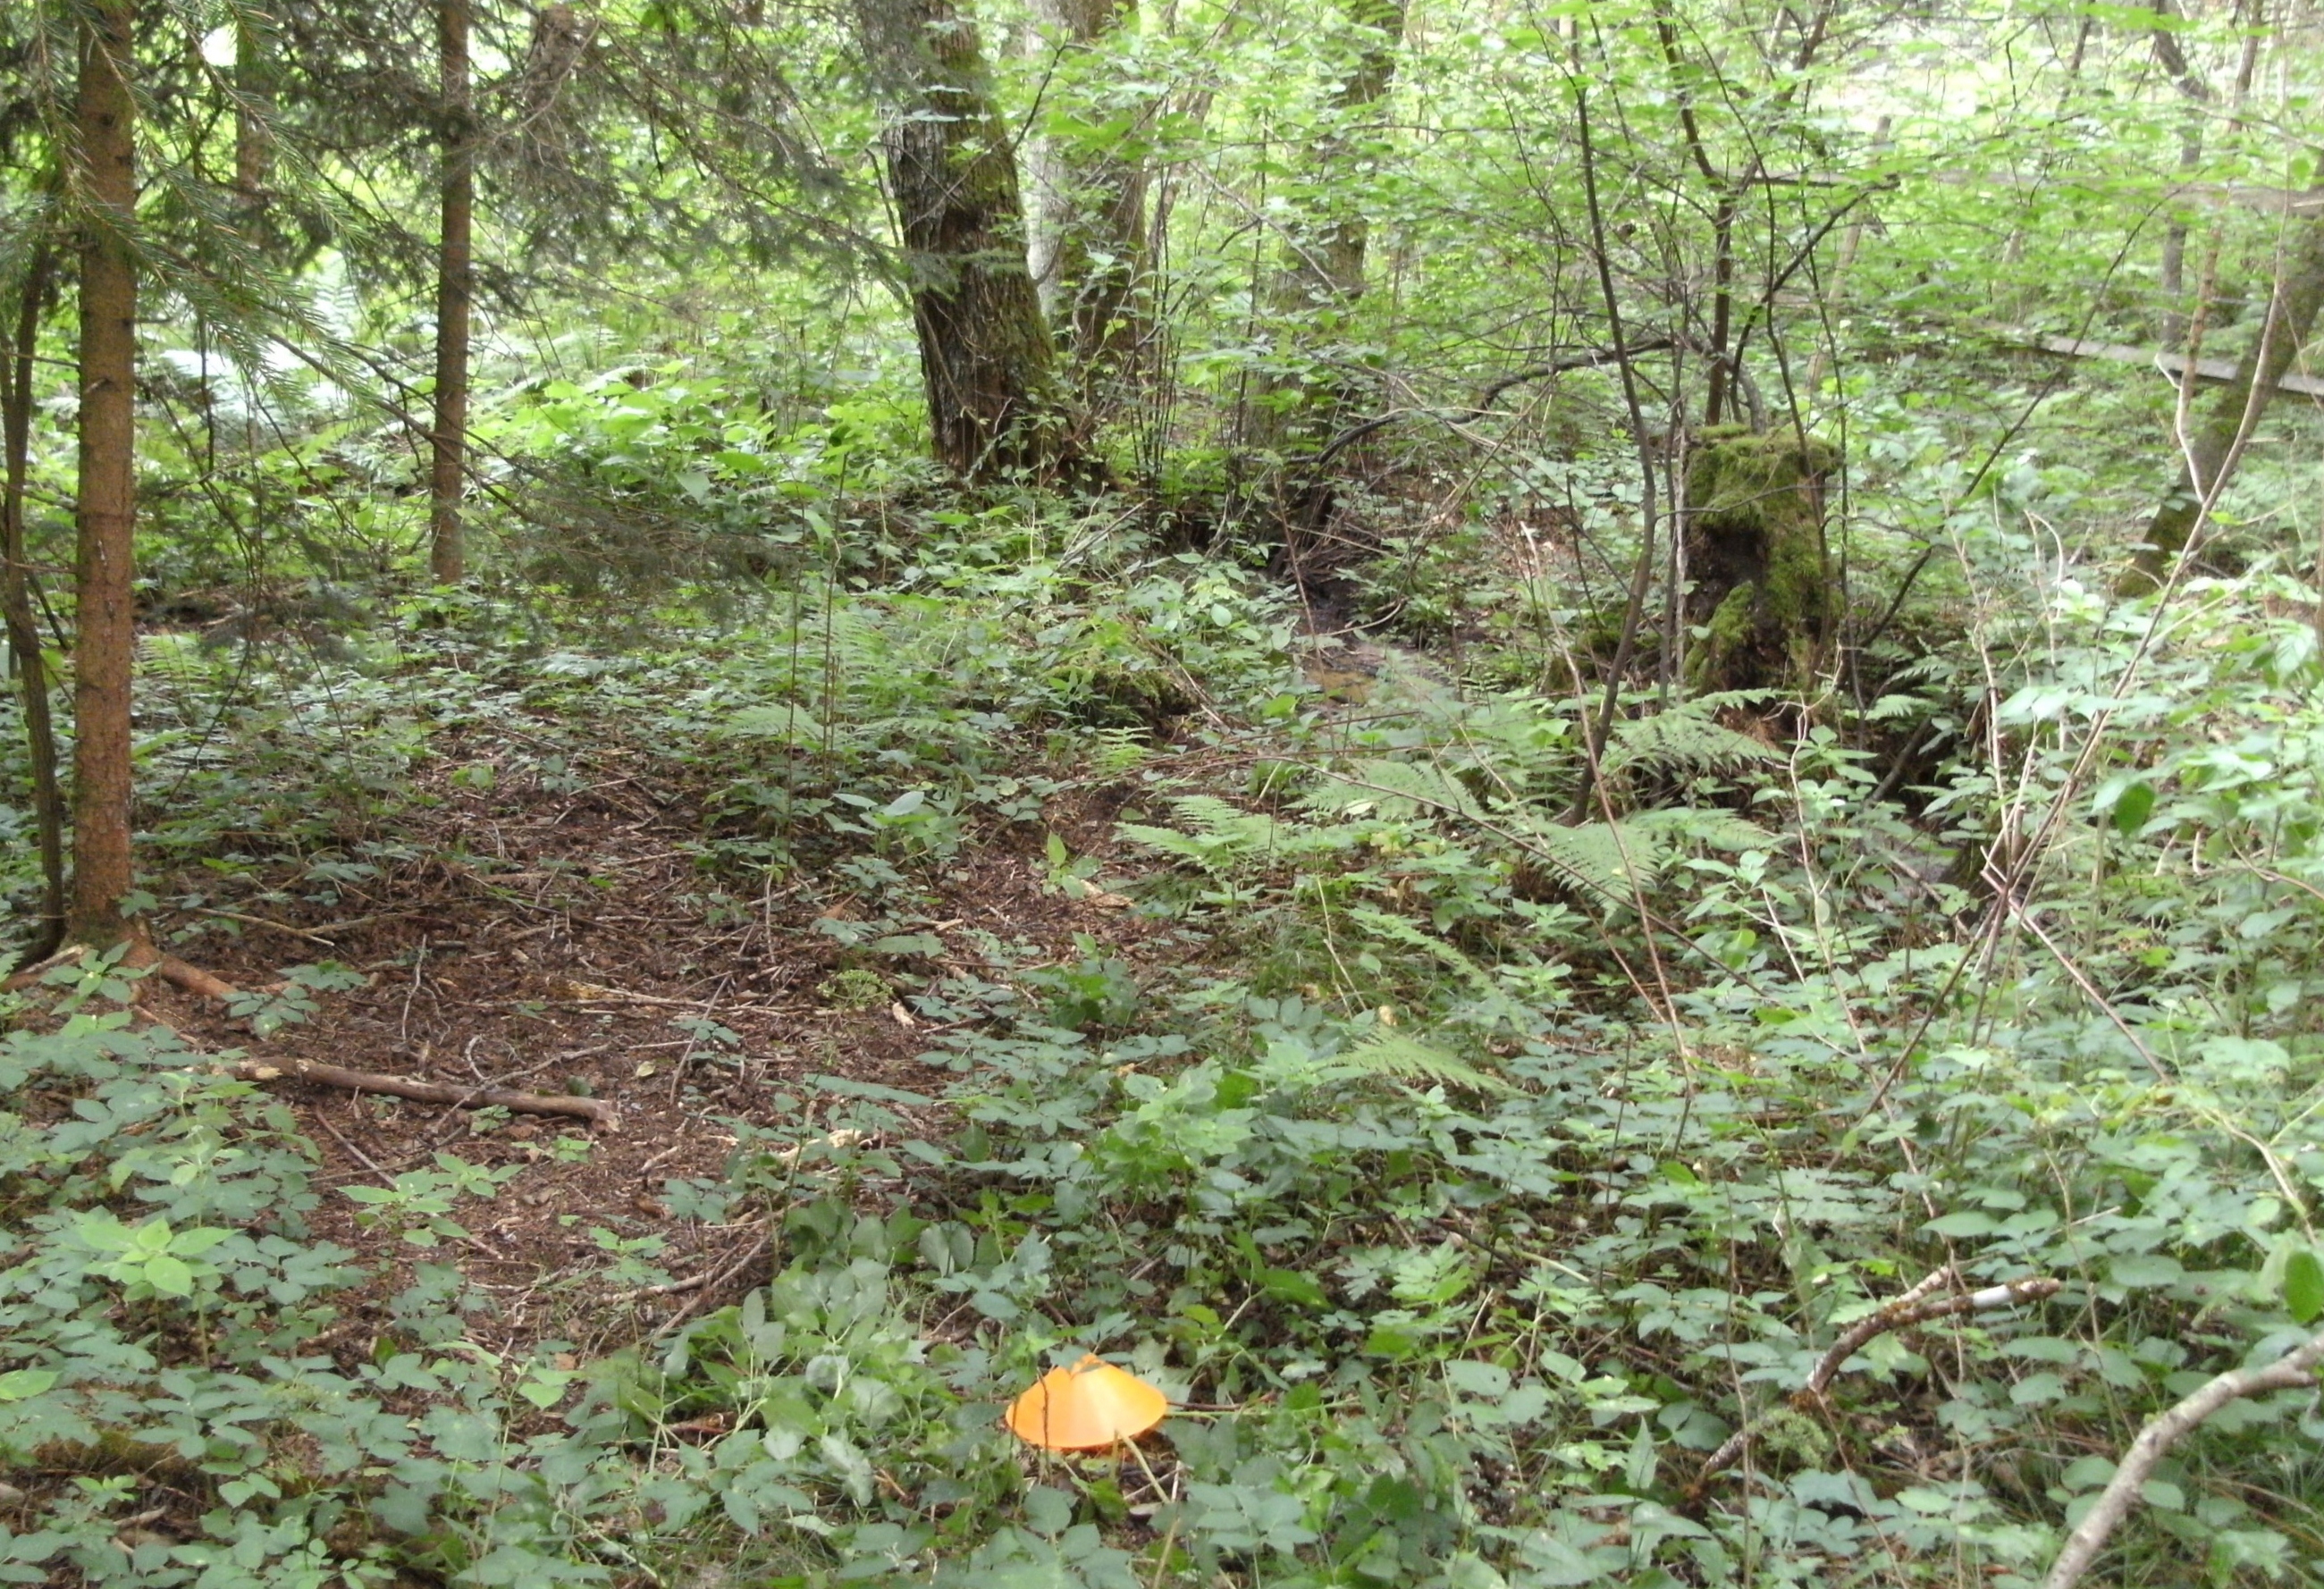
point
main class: Woodland
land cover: Spruce dominated mixed woodland
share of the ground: > 75 %
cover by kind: coniferous forest trees 40 %, broadleaved forest trees 40 %, shrubs 10 %, herbaceous plants 10 %
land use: Forestry
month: July
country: AT
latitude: 46.8036
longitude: 14.7809
